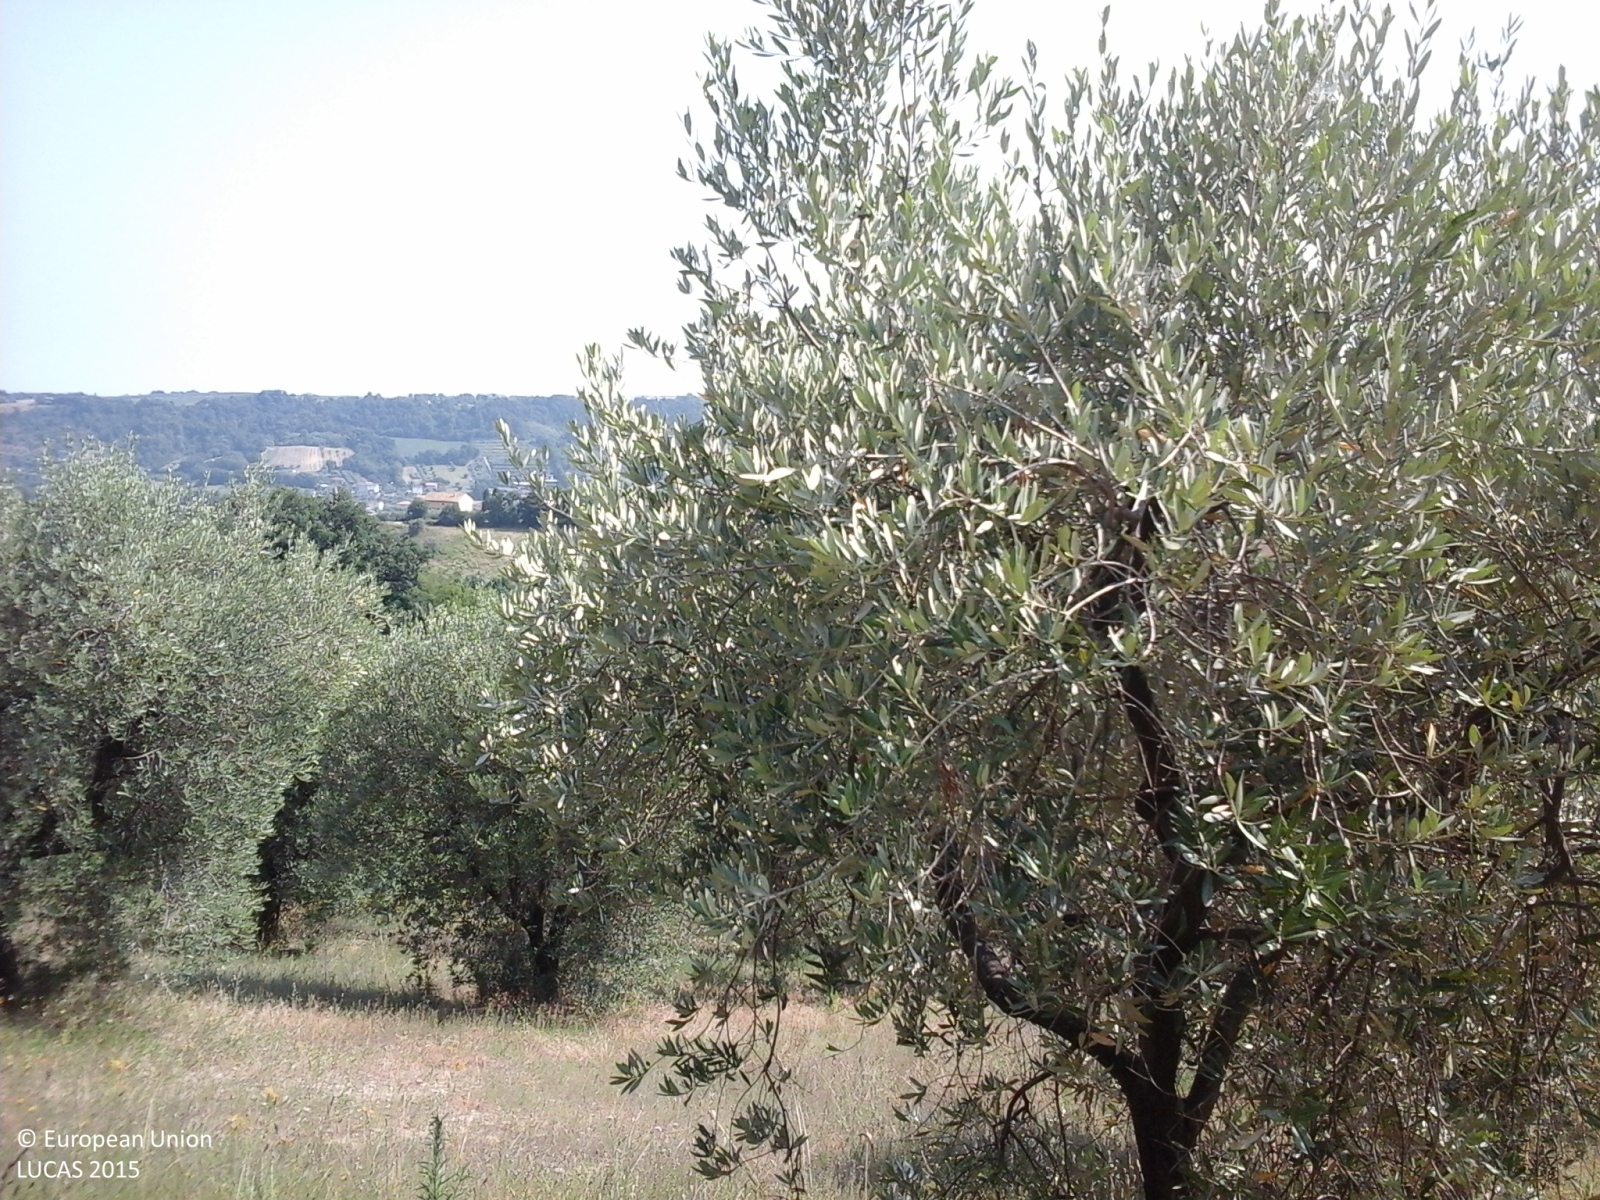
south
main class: Cropland
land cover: Olive groves
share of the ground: 10 - 25 %
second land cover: Grassland without tree/shrub cover
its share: 50 - 75 %
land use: Agriculture (excluding fallow land and kitchen gardens)
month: July
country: IT
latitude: 43.0515
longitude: 13.8326
